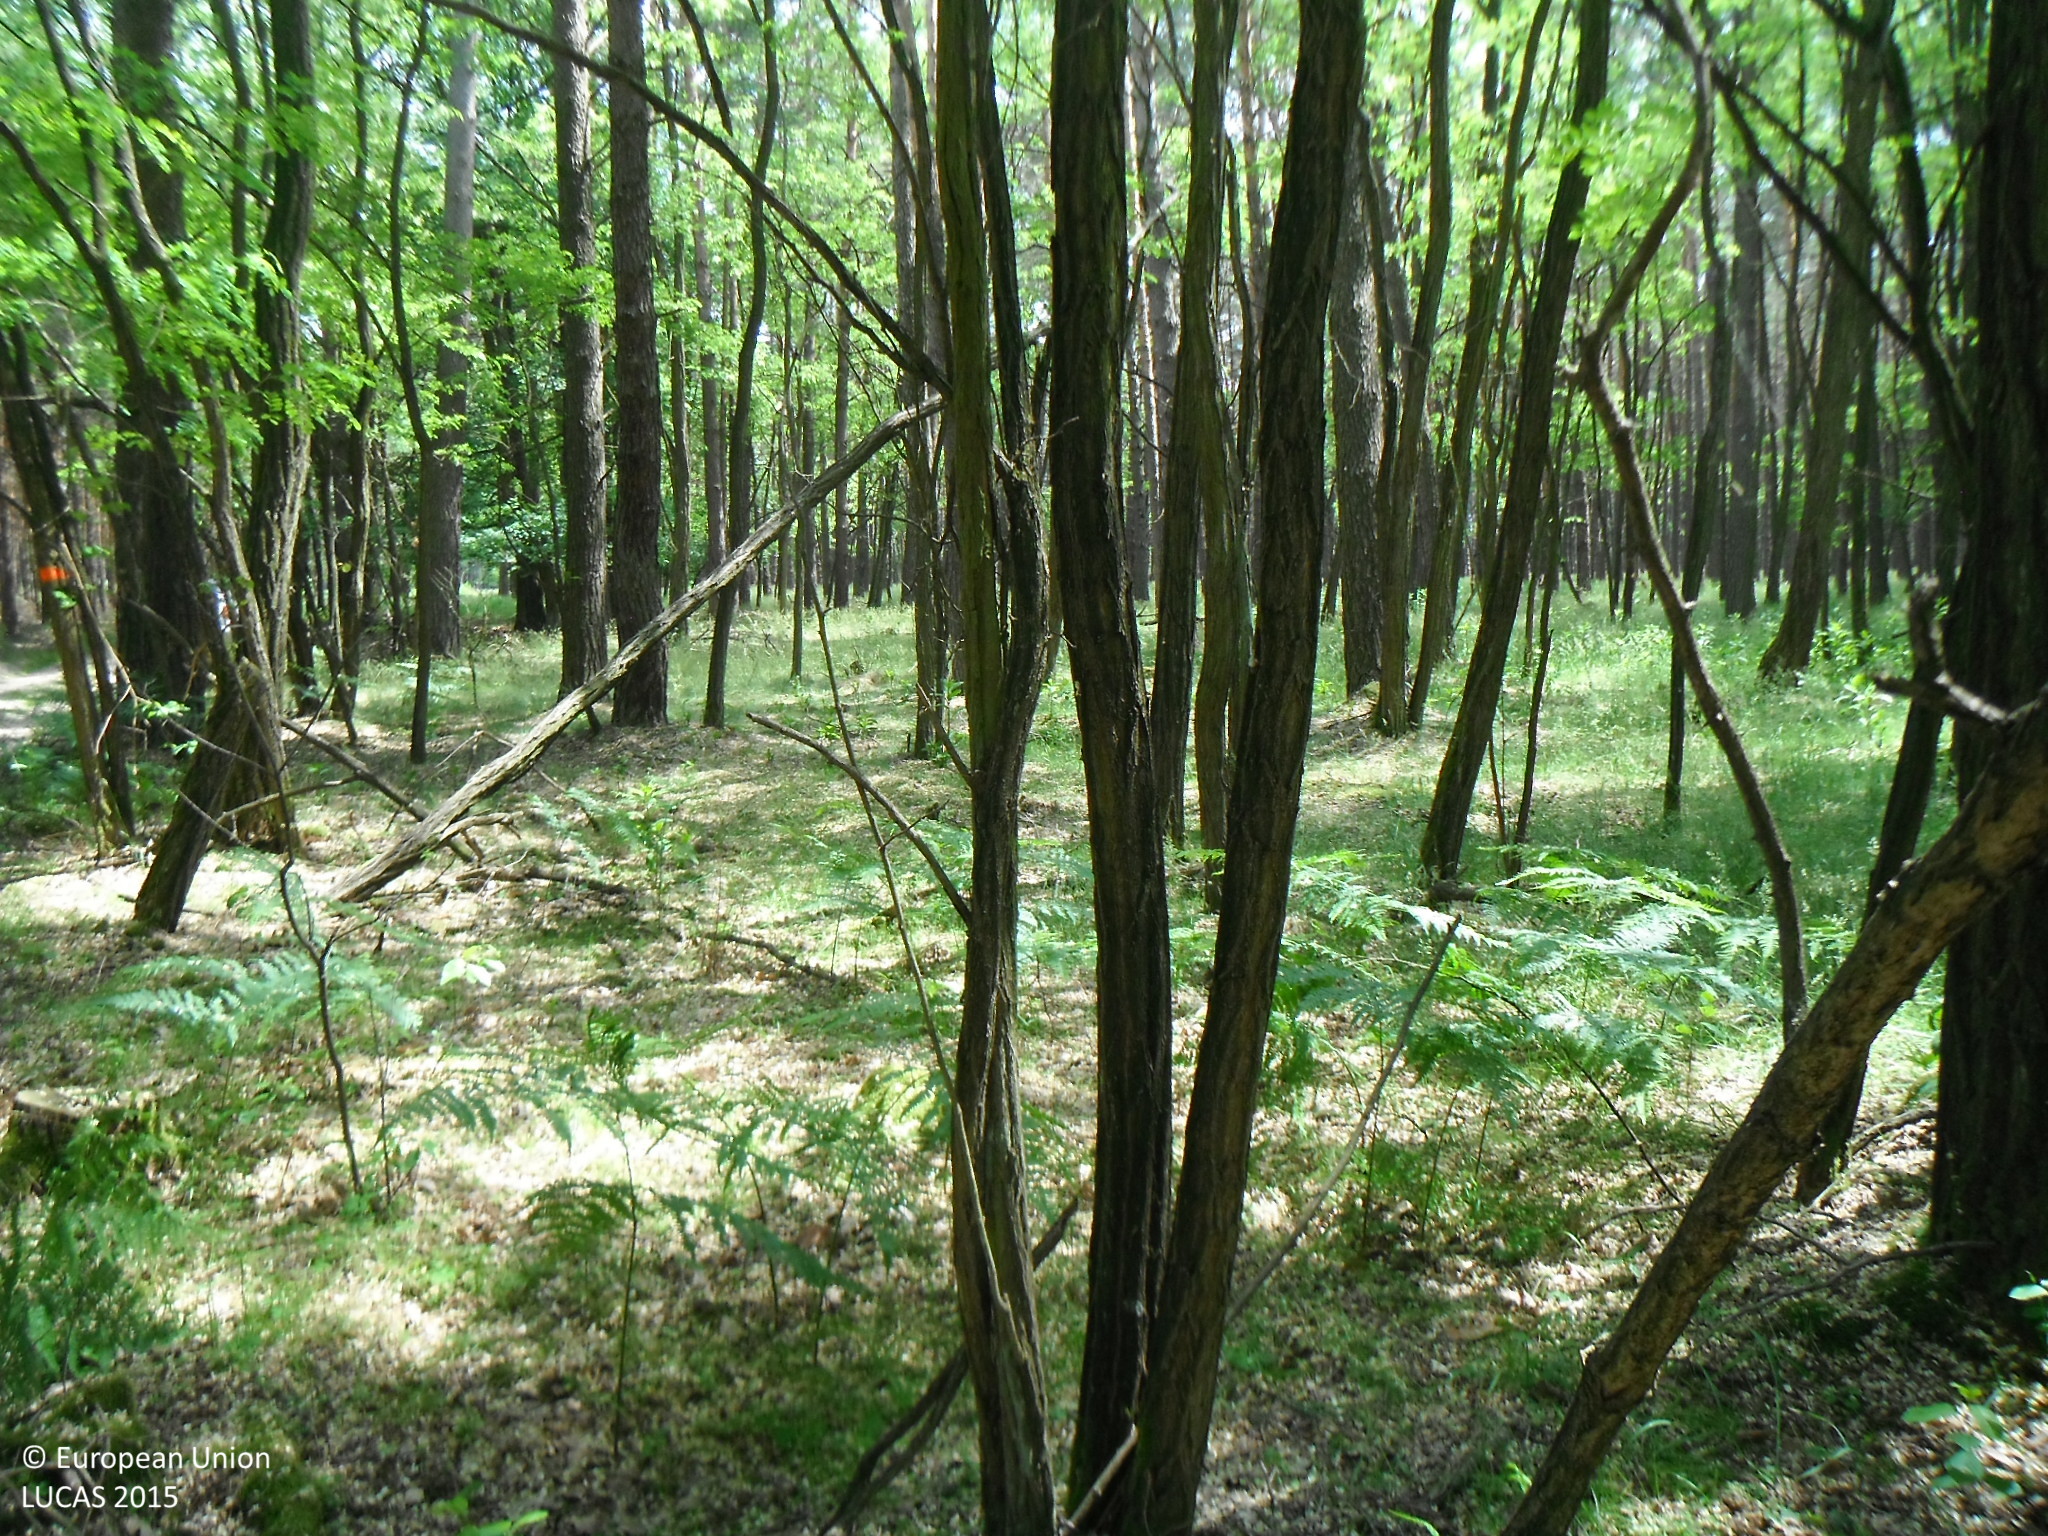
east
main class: Woodland
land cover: Broadleaved woodland
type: exotic forest
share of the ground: > 75 %
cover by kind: broadleaved forest trees 85 %, shrubs 5 %, herbaceous plants 5 %, unconsolidated bare surface 5 %
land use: Forestry
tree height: > 5 m
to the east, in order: Broadleaved woodland; Pine dominated mixed woodland; Pine dominated coniferous woodland
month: June
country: SK
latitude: 48.5513
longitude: 17.1484
